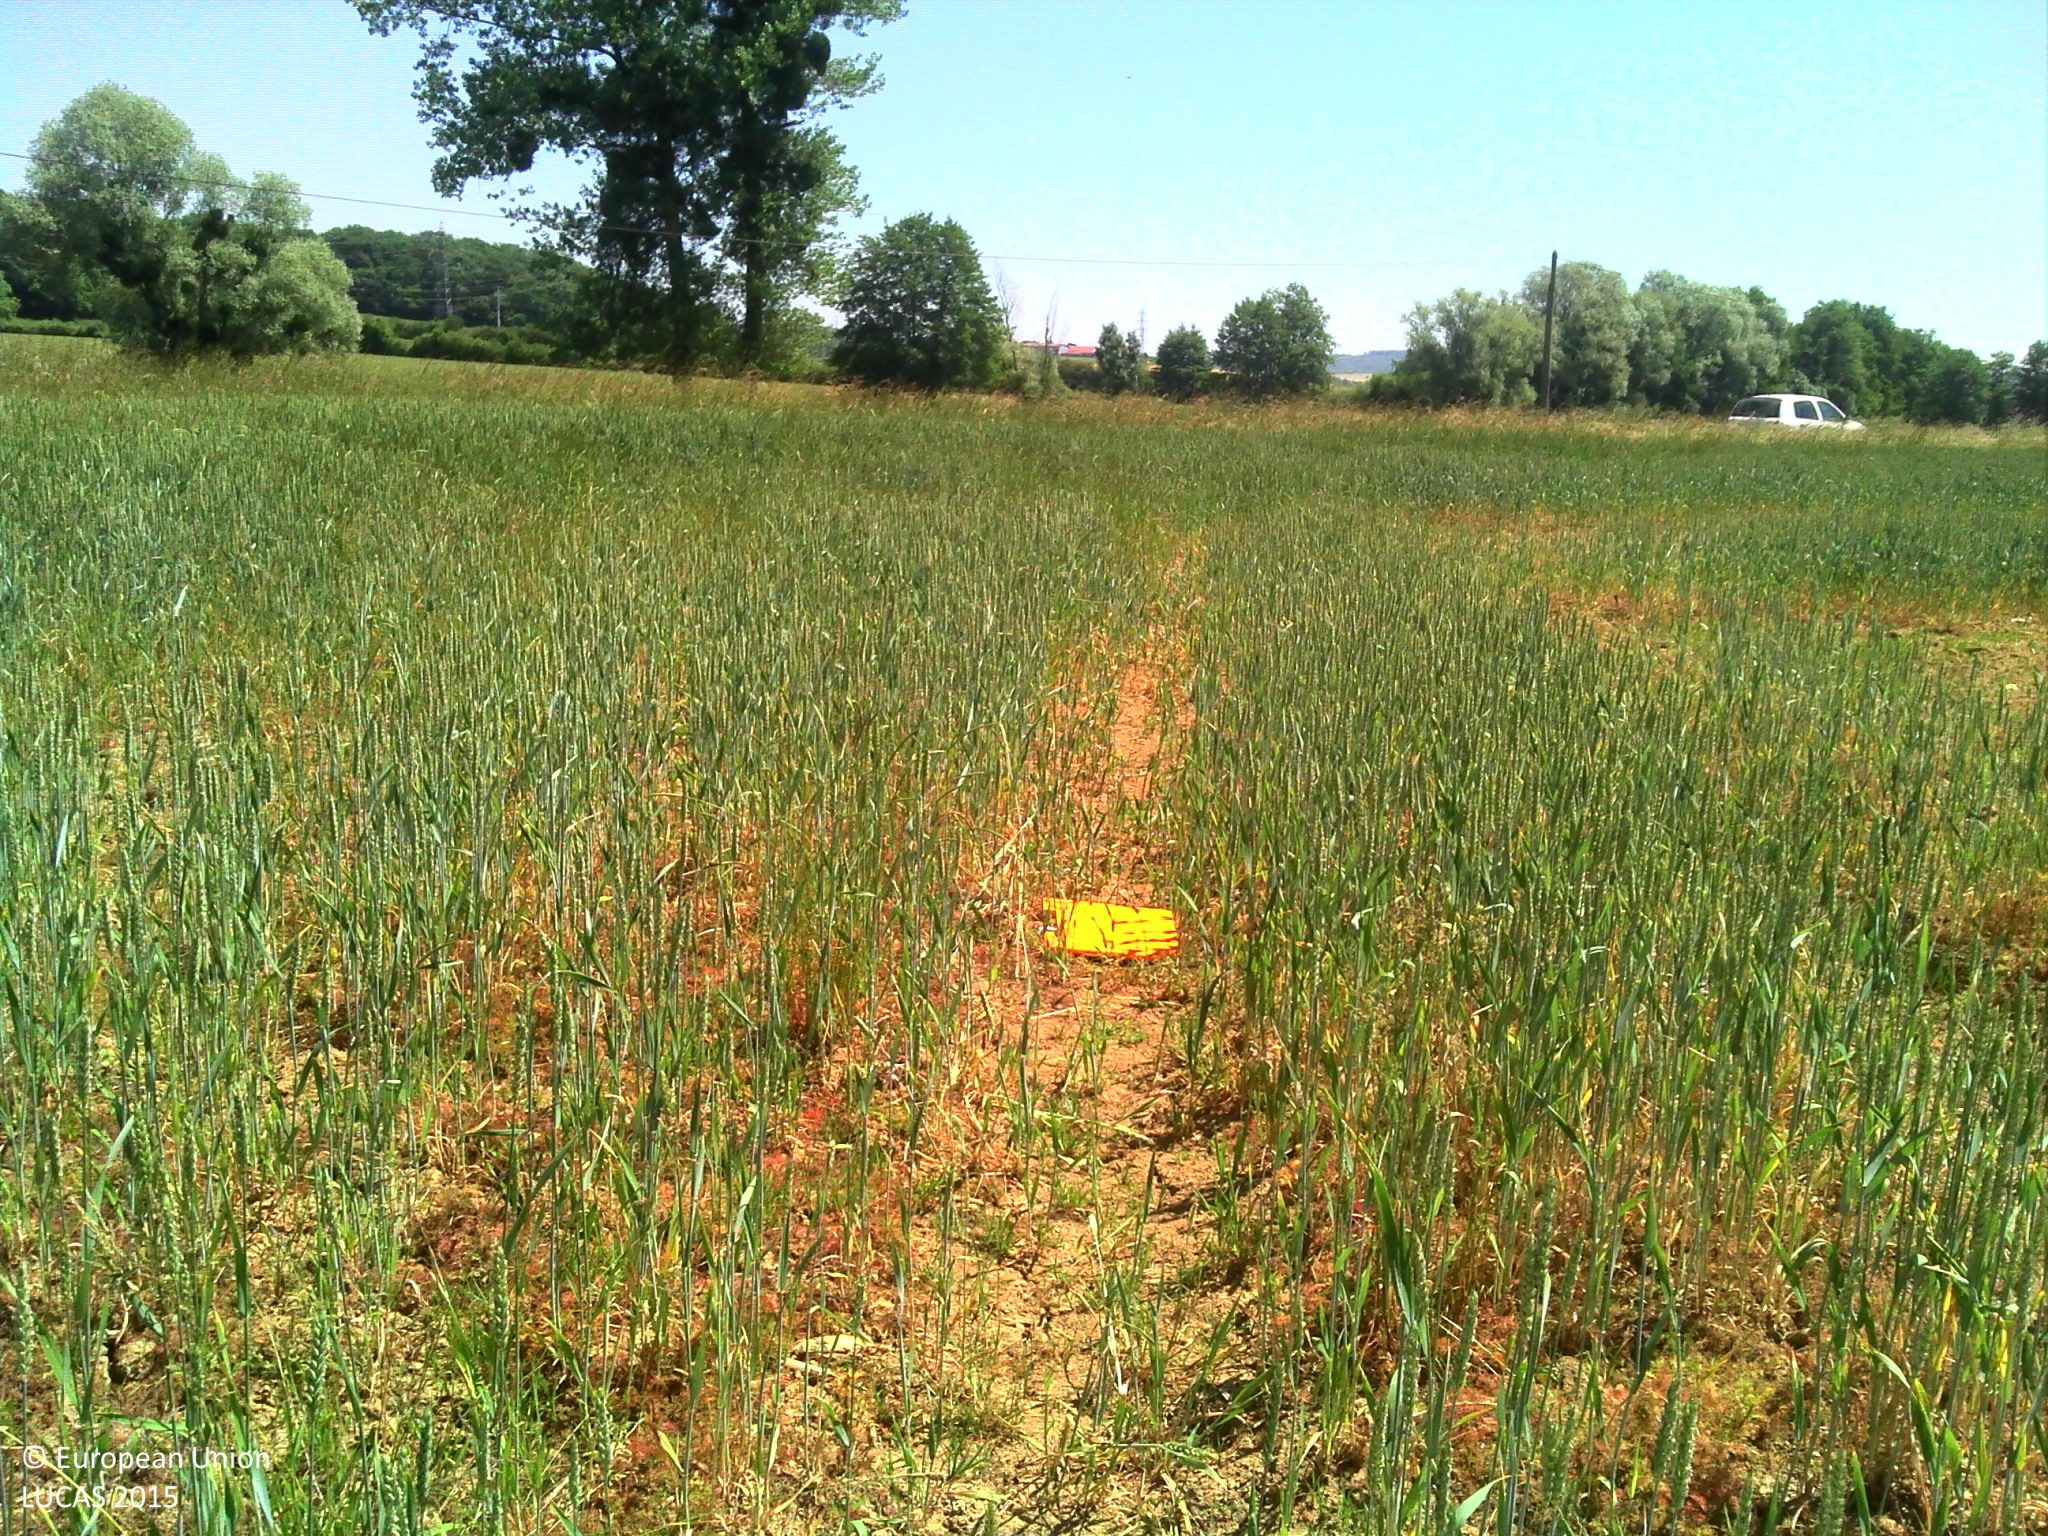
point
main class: Cropland
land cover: Common wheat
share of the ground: > 75 %
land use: Agriculture (excluding fallow land and kitchen gardens)
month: June
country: FR
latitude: 47.6690
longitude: 6.1257
